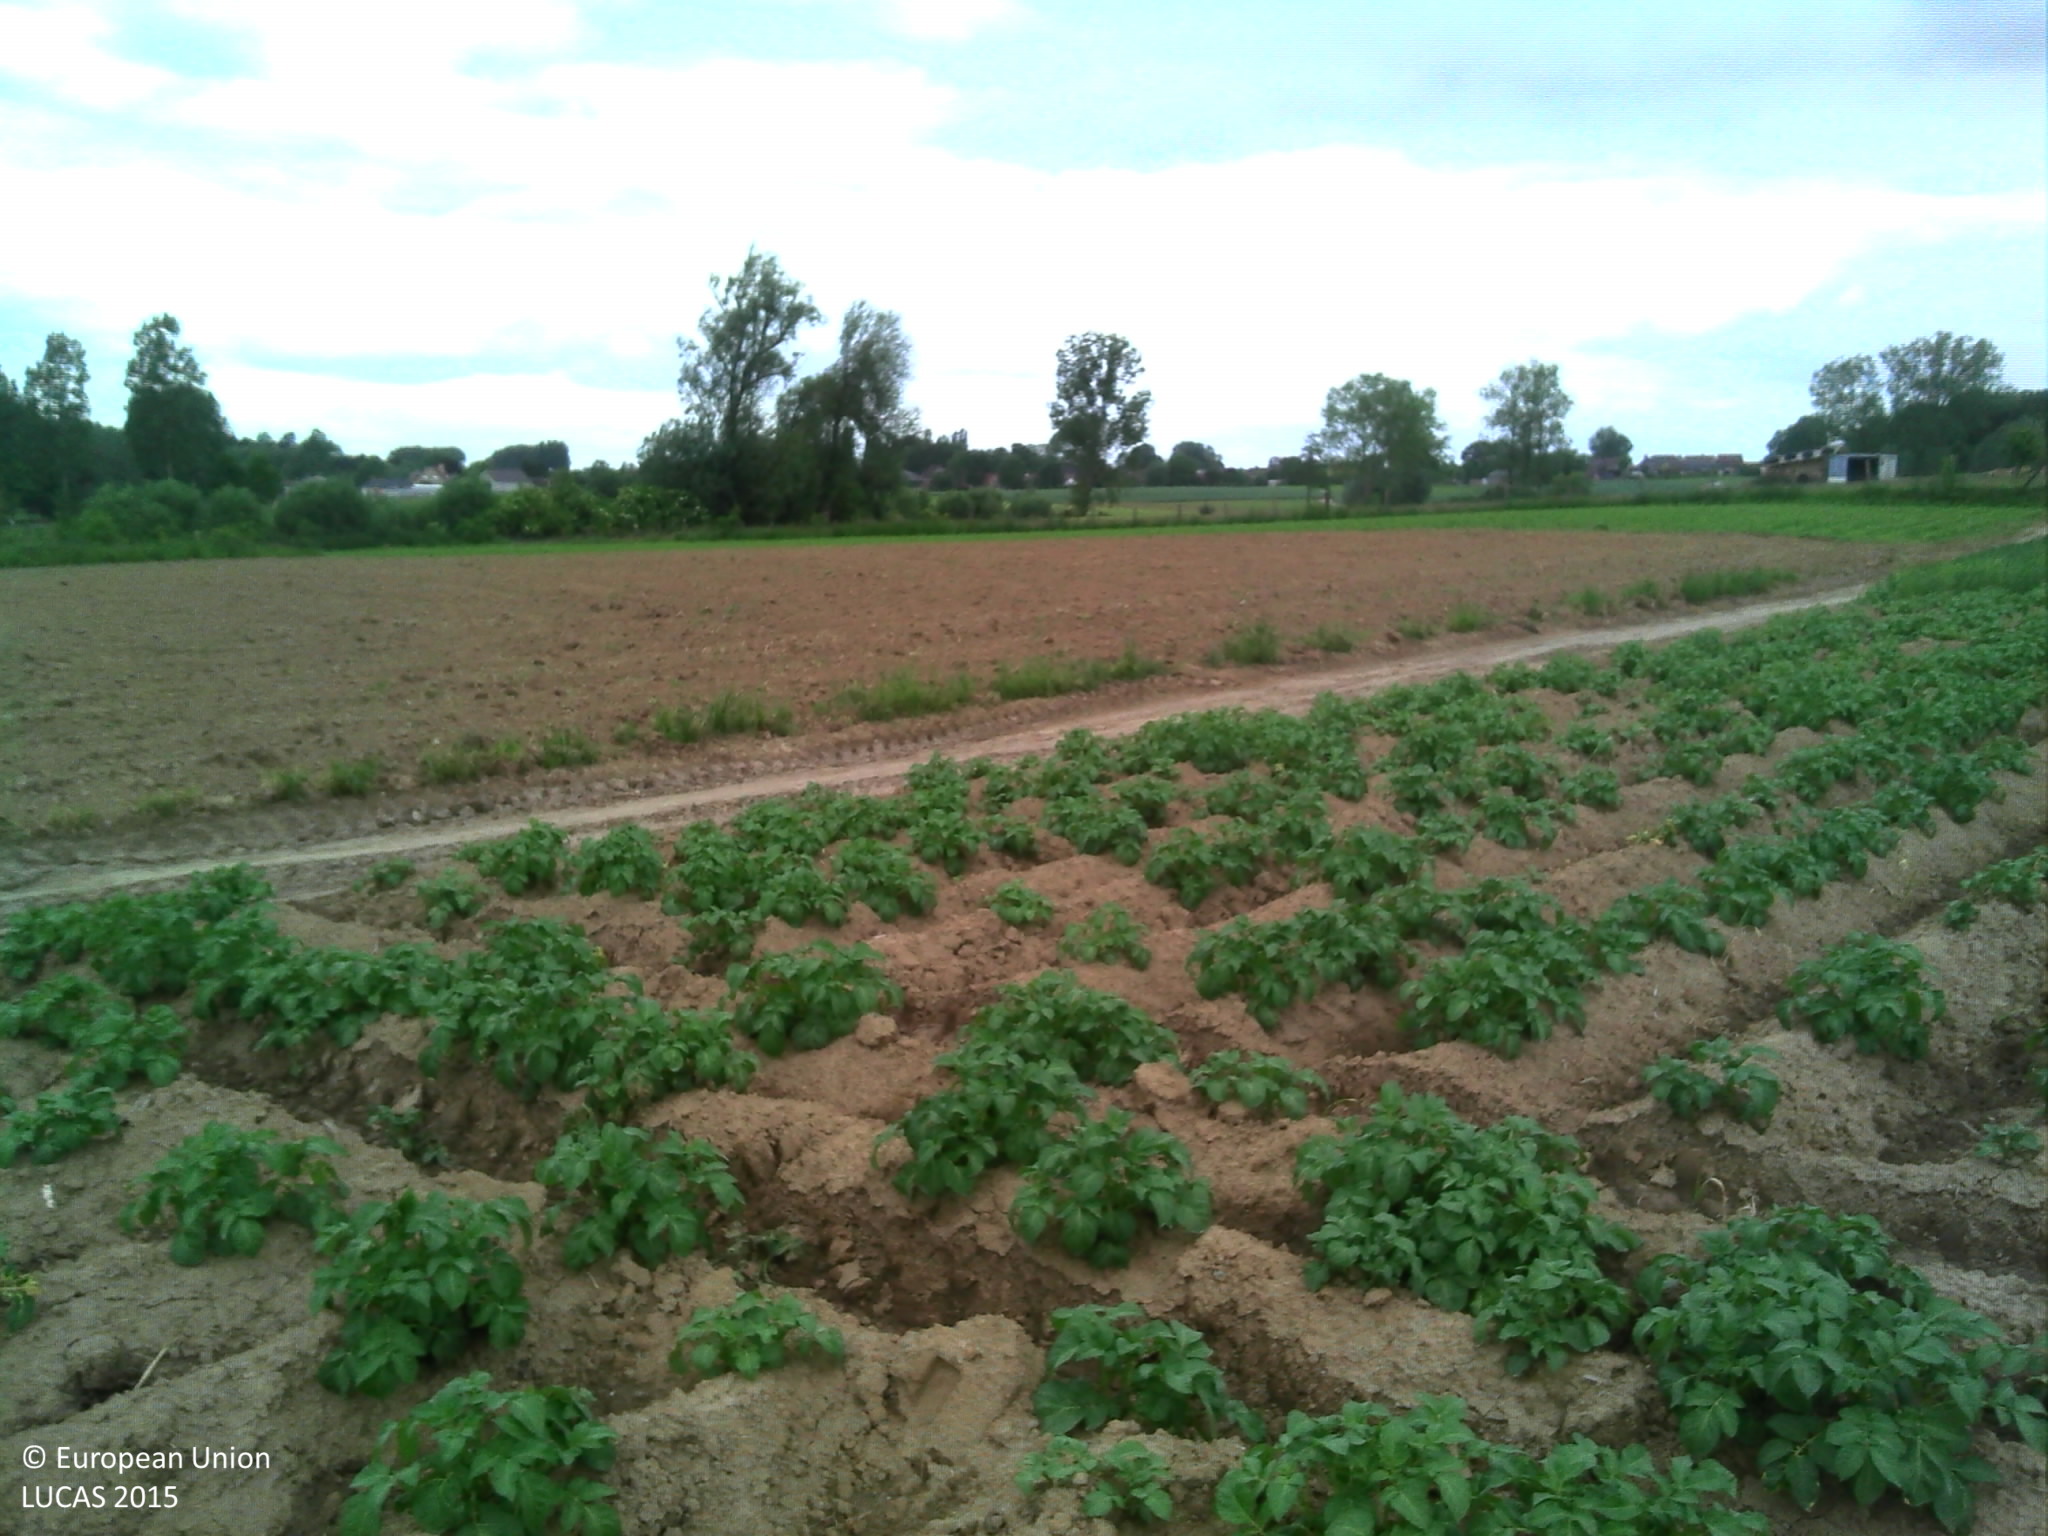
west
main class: Cropland
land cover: Potatoes
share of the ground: 50 - 75 %
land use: Agriculture (excluding fallow land and kitchen gardens)
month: June
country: BE
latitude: 50.8877
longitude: 3.9239
